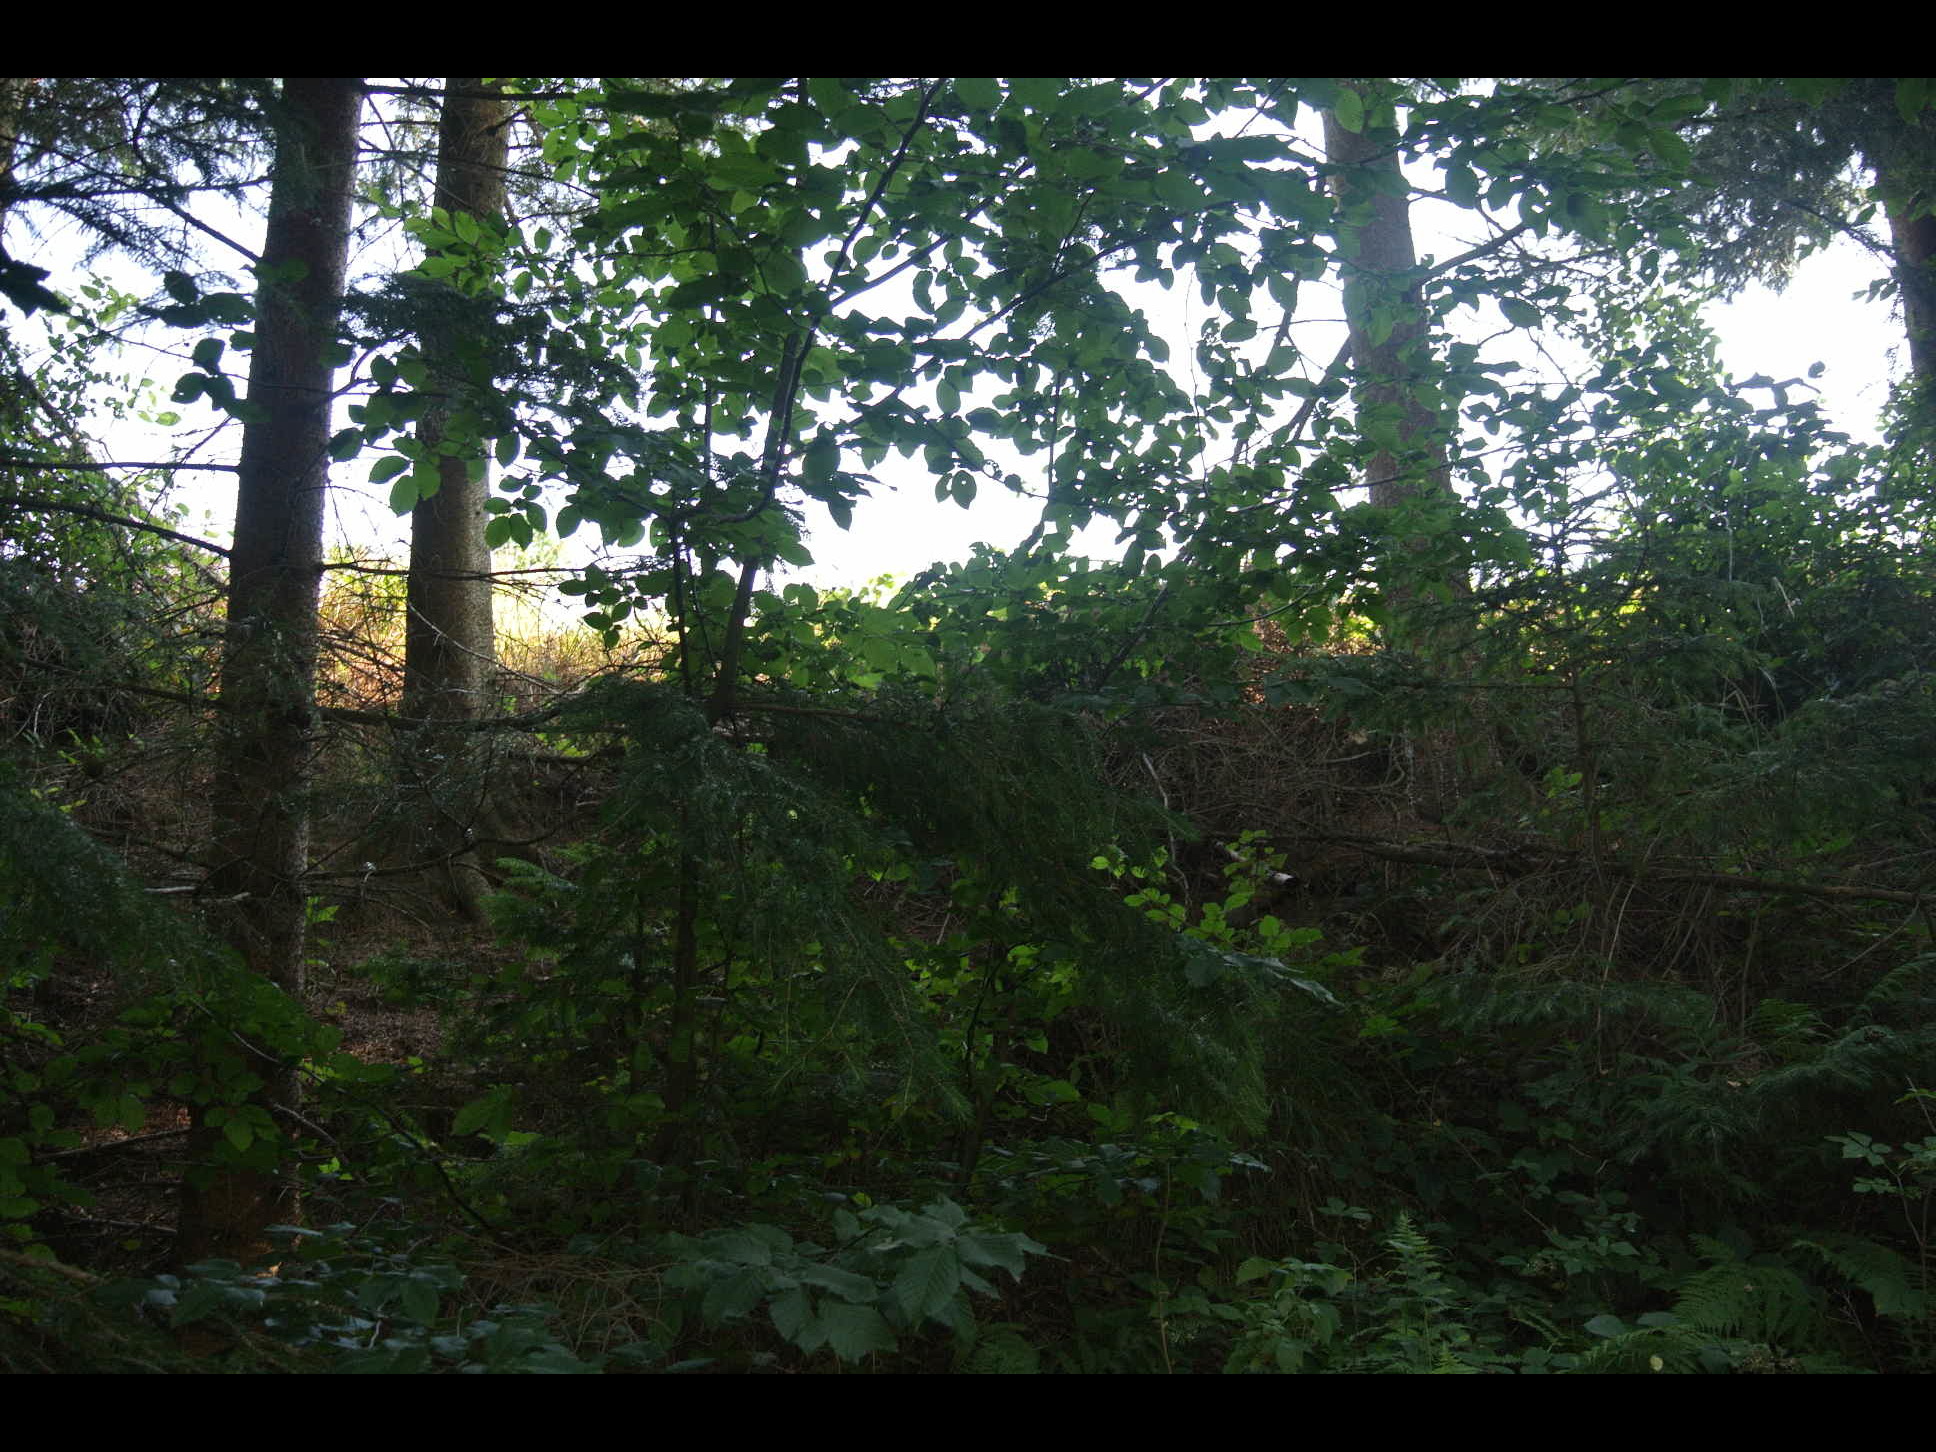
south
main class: Woodland
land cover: Spruce dominated mixed woodland
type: alpine coniferous forest
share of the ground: > 75 %
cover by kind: coniferous forest trees 70 %, broadleaved forest trees 30 %
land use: Forestry
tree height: > 5 m
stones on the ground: < 10 %
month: July
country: AT
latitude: 47.6568
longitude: 16.1144
